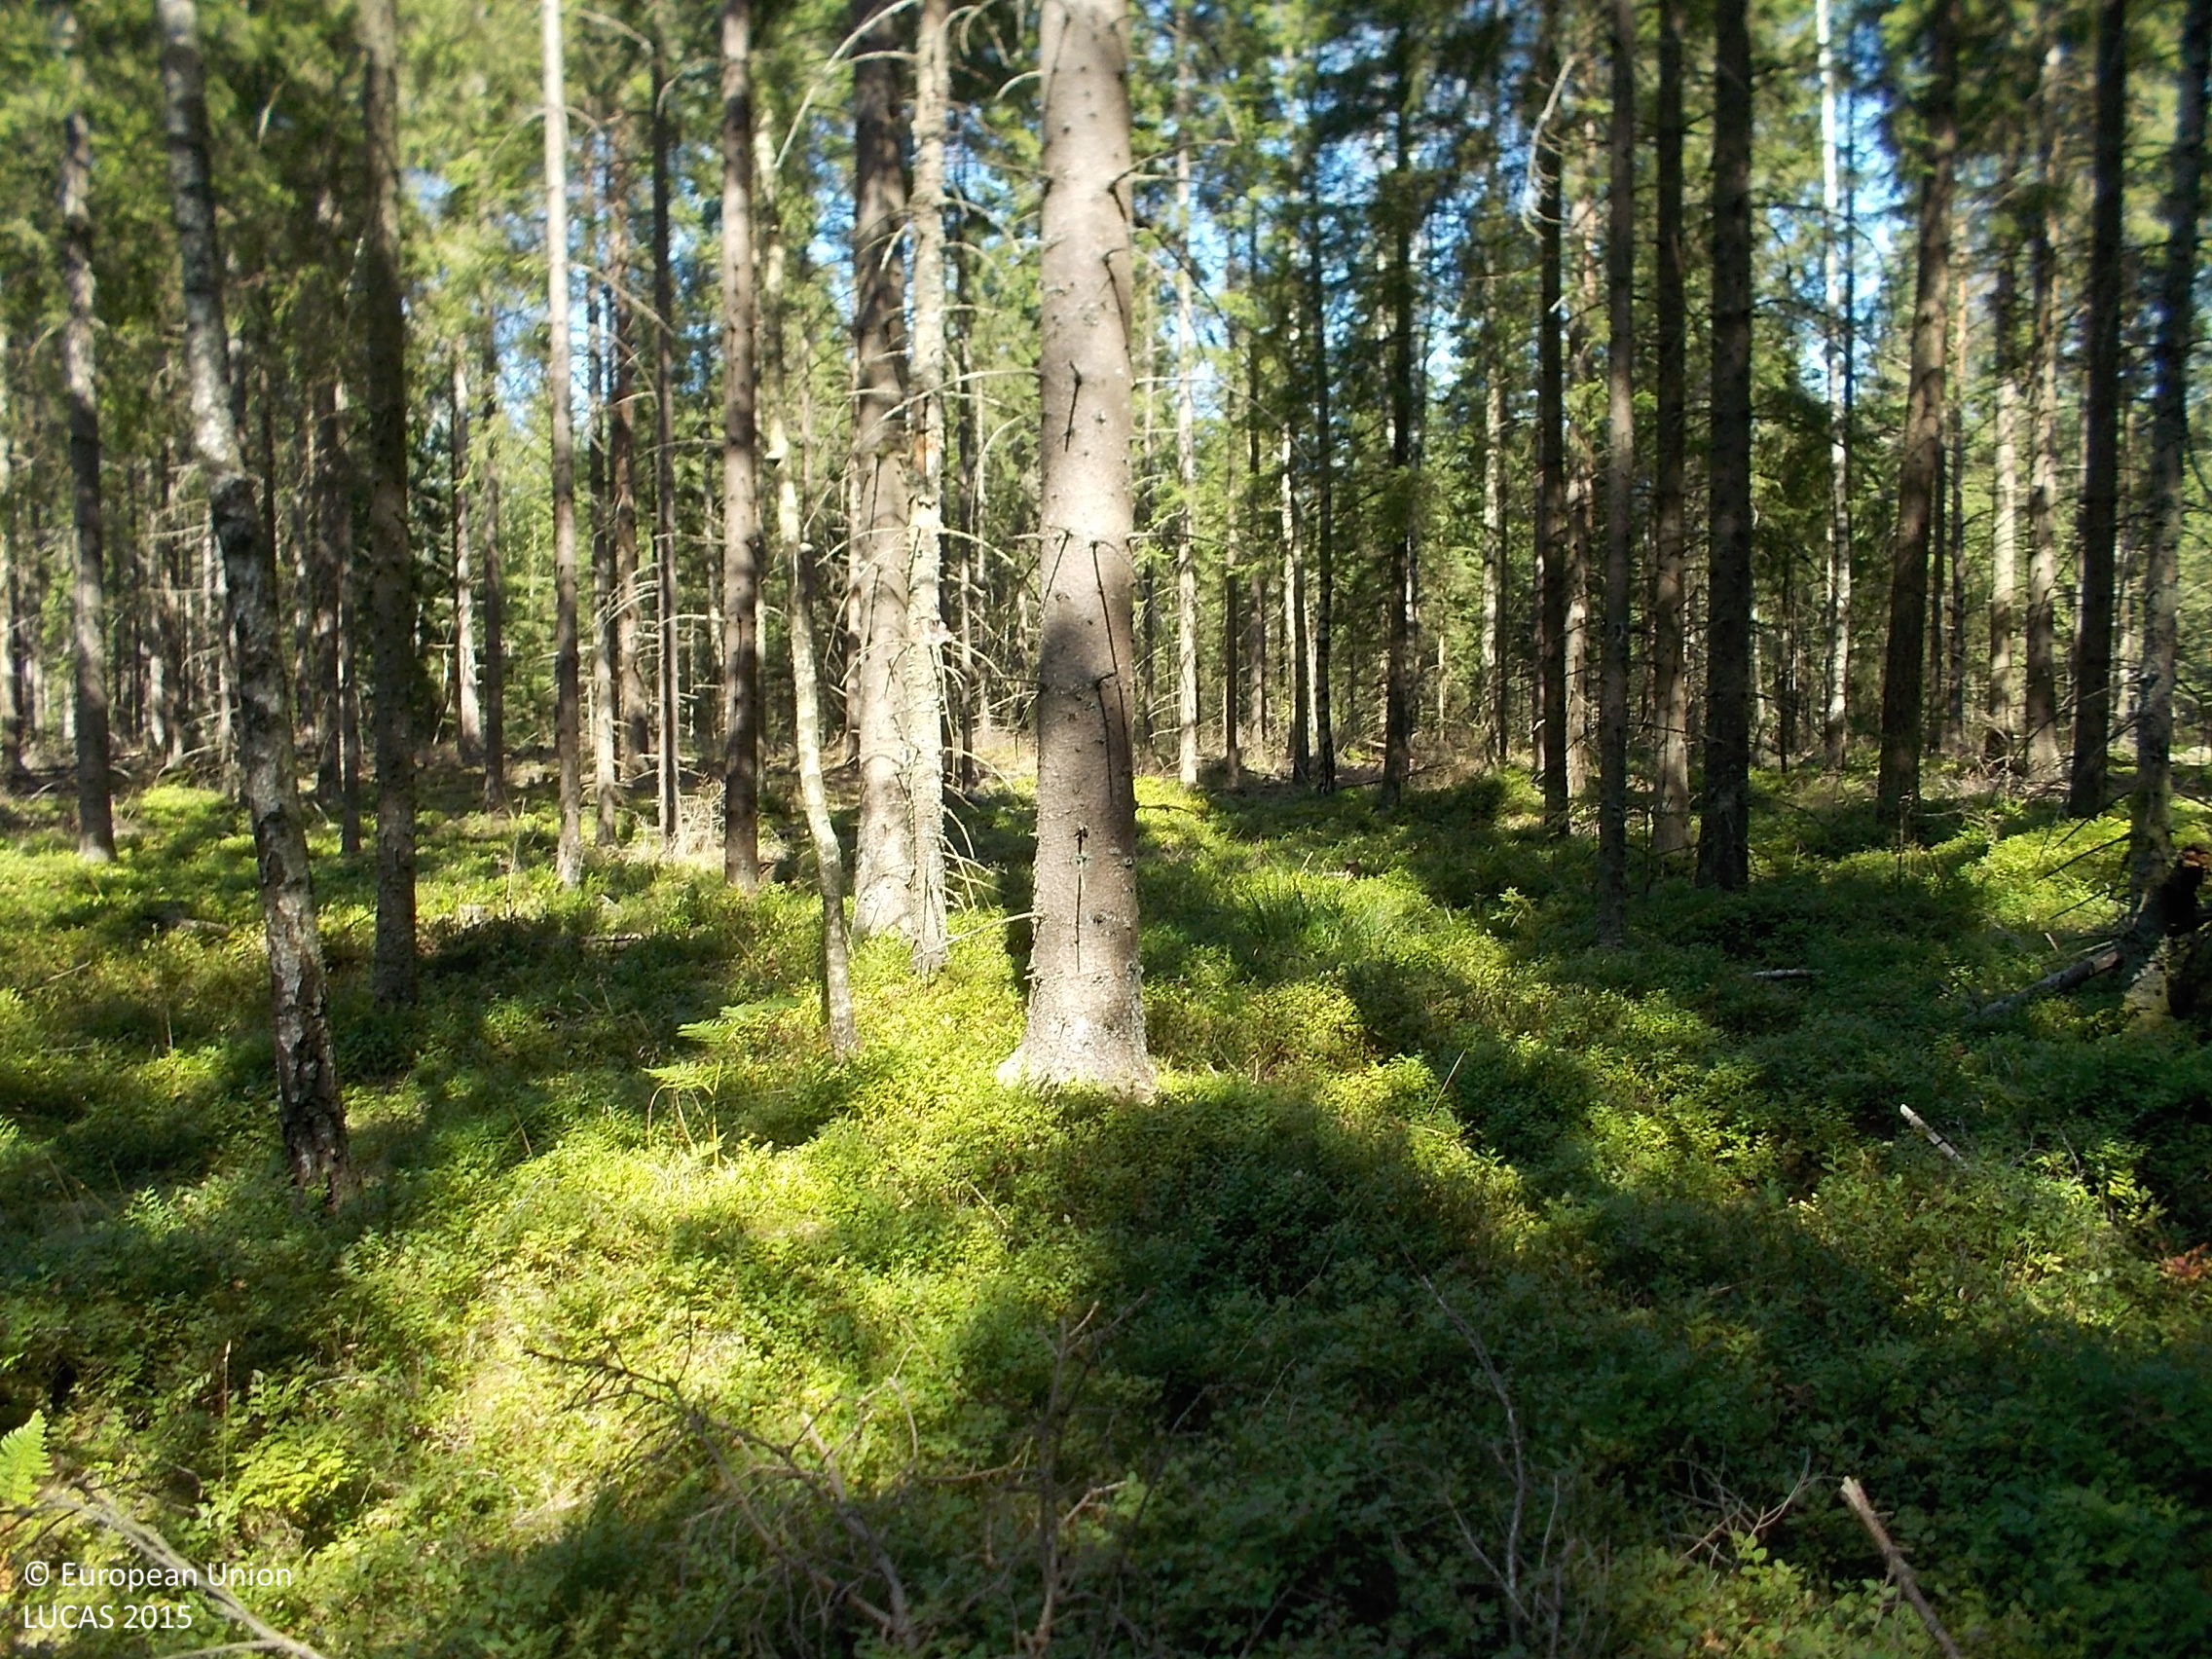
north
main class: Woodland
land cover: Spruce dominated coniferous woodland
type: boreal forest
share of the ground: > 75 %
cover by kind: coniferous forest trees 85 %, shrubs 10 %, herbaceous plants 5 %
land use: Forestry
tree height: > 5 m
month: August
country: SE
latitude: 57.4783
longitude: 13.2478
